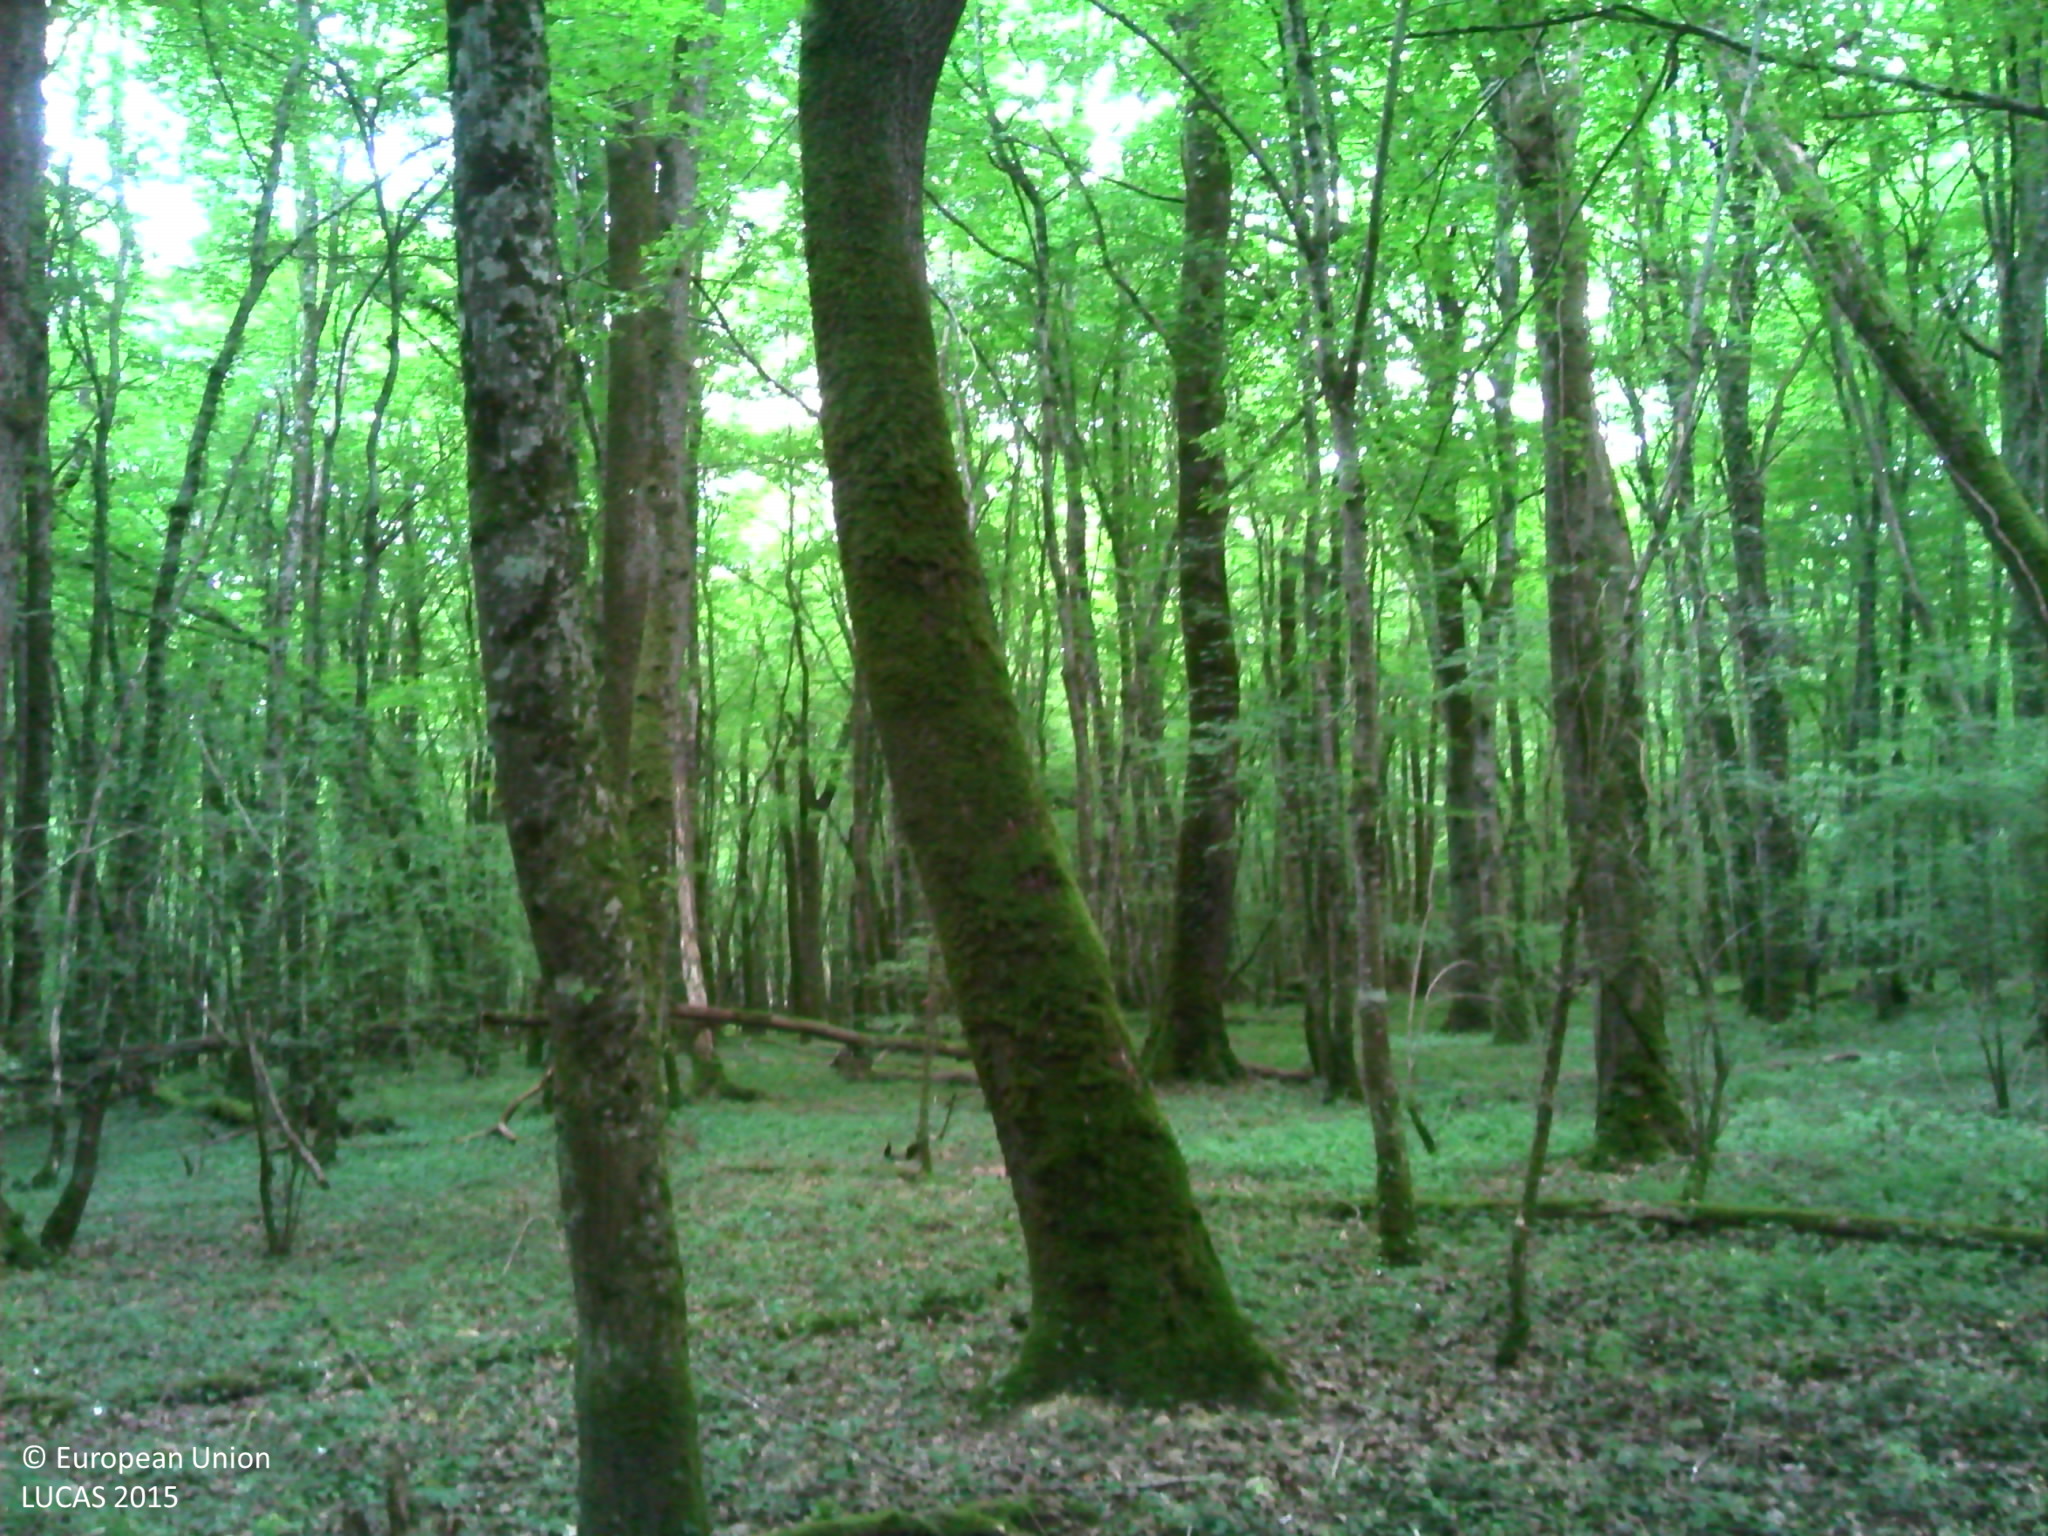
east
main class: Woodland
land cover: Broadleaved woodland
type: beech forest
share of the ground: > 75 %
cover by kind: broadleaved forest trees 90 %, herbaceous plants 10 %
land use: Forestry
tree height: > 5 m
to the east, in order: Broadleaved woodland
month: July
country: FR
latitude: 47.3158
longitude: 3.6074
